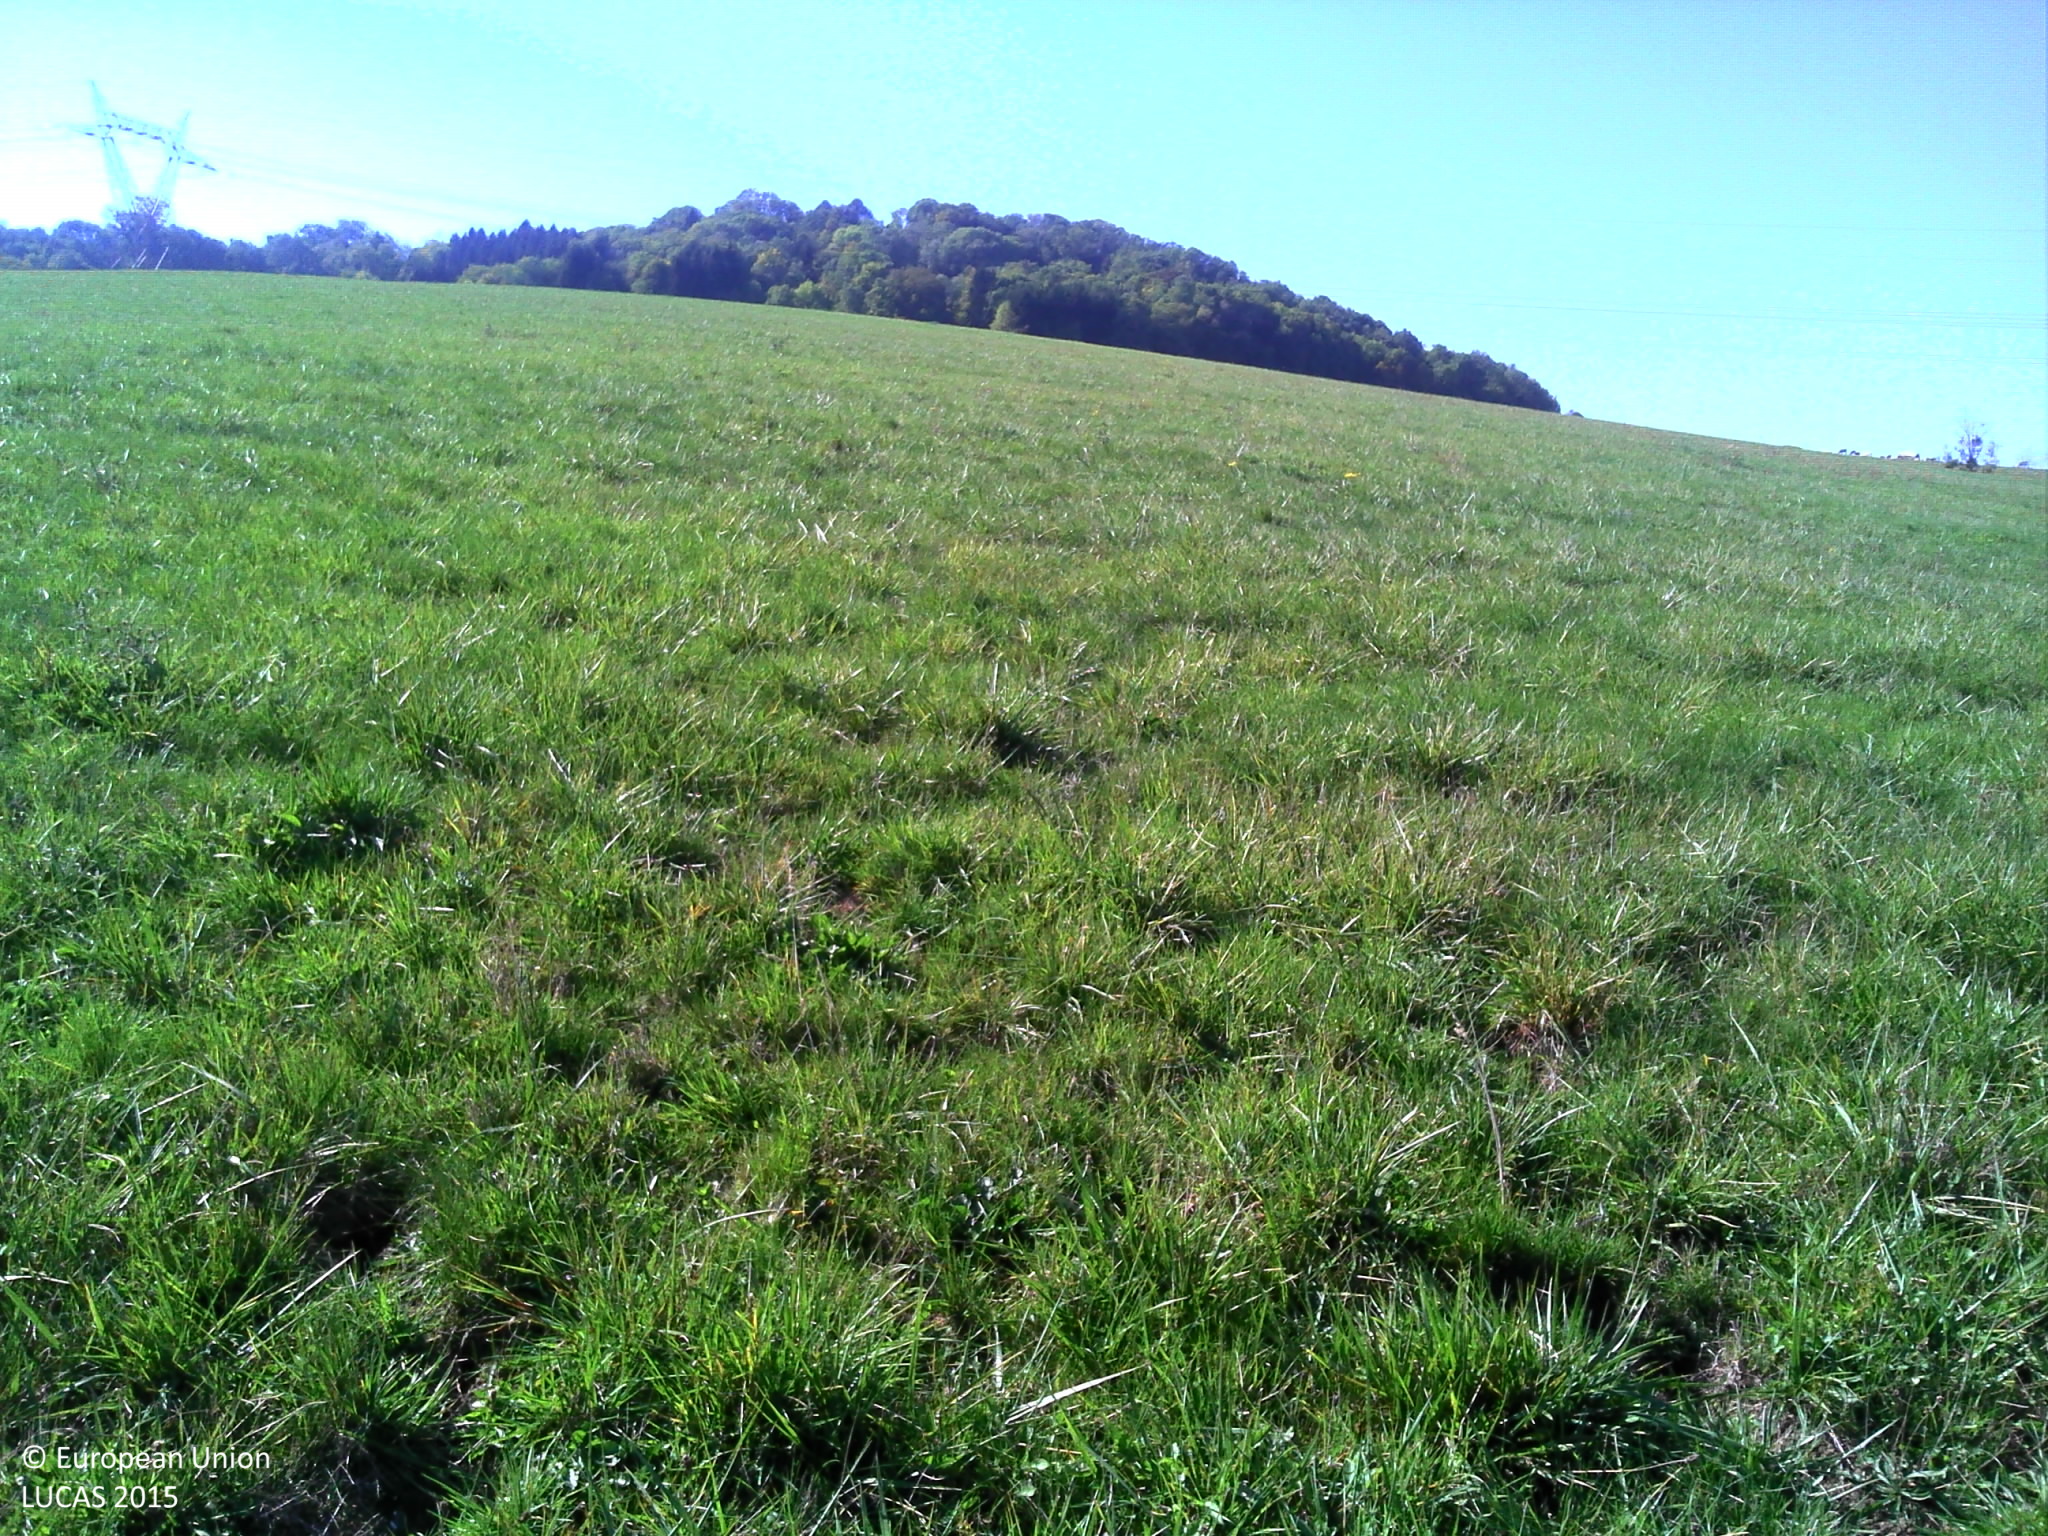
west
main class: Grassland
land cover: Grassland without tree/shrub cover
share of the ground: > 75 %
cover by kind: herbaceous plants 95 %, consolidated bare surface 5 %
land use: Agriculture (excluding fallow land and kitchen gardens)
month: October
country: FR
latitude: 48.9625
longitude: 6.0250
